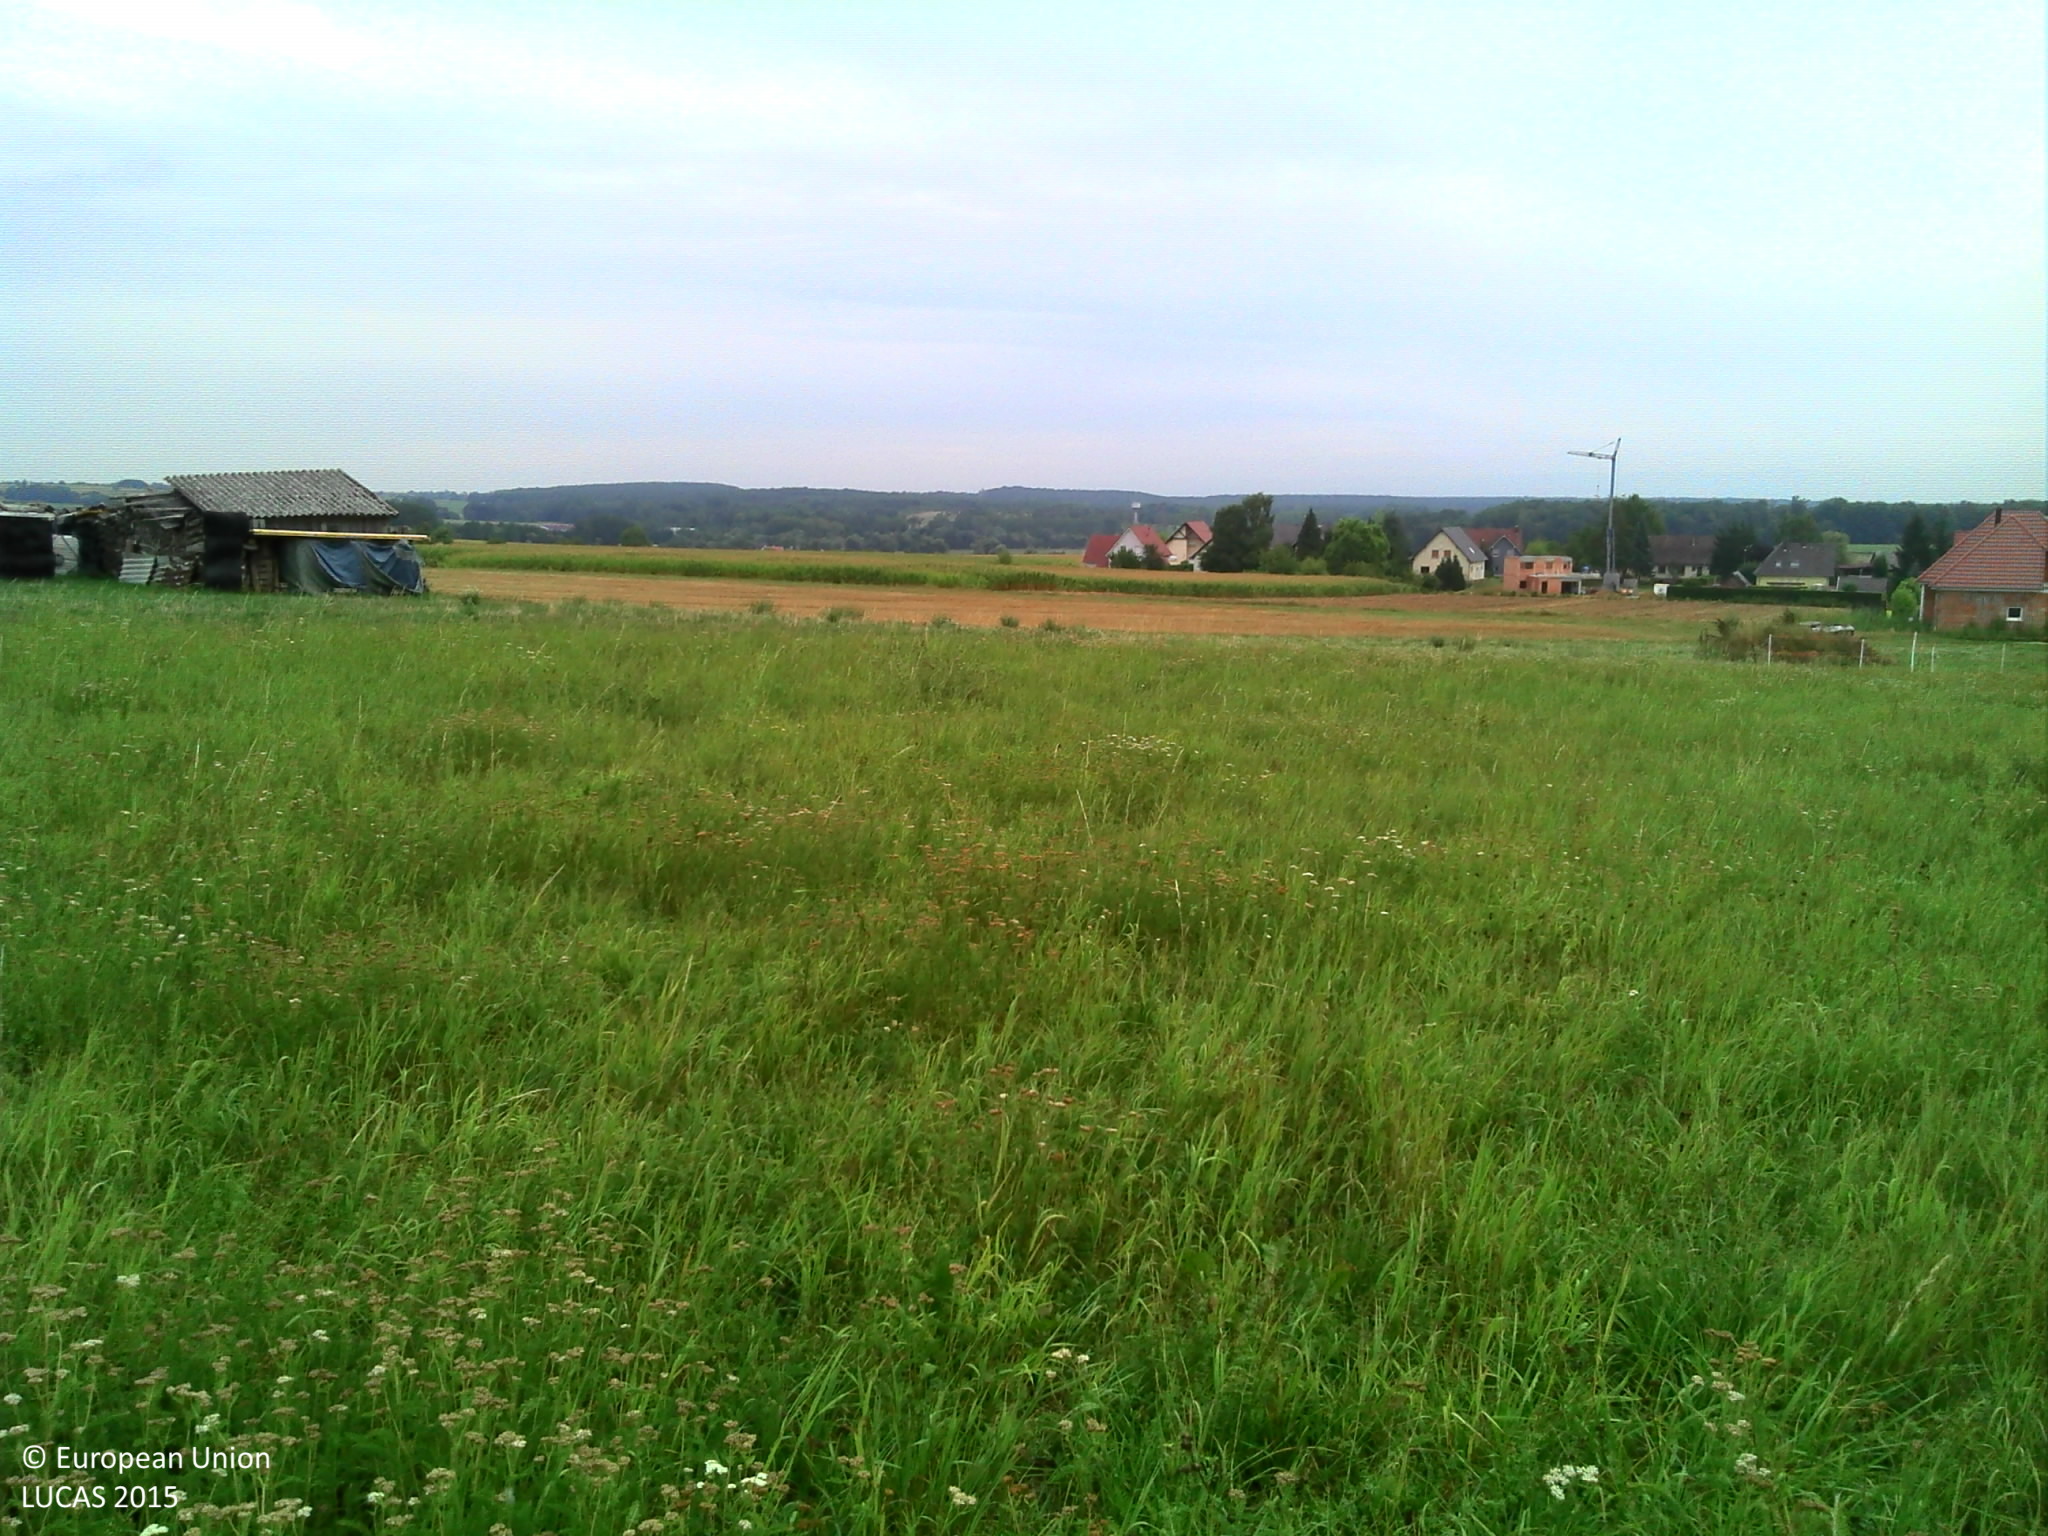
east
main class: Grassland
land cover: Grassland without tree/shrub cover
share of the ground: > 75 %
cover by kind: herbaceous plants 100 %
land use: Agriculture (excluding fallow land and kitchen gardens)
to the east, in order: Grassland without tree/shrub cover; Common wheat; Grass margins; Tracks; Grass margins; Maize; Triticale
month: August
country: FR
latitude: 48.8823
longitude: 7.6415
